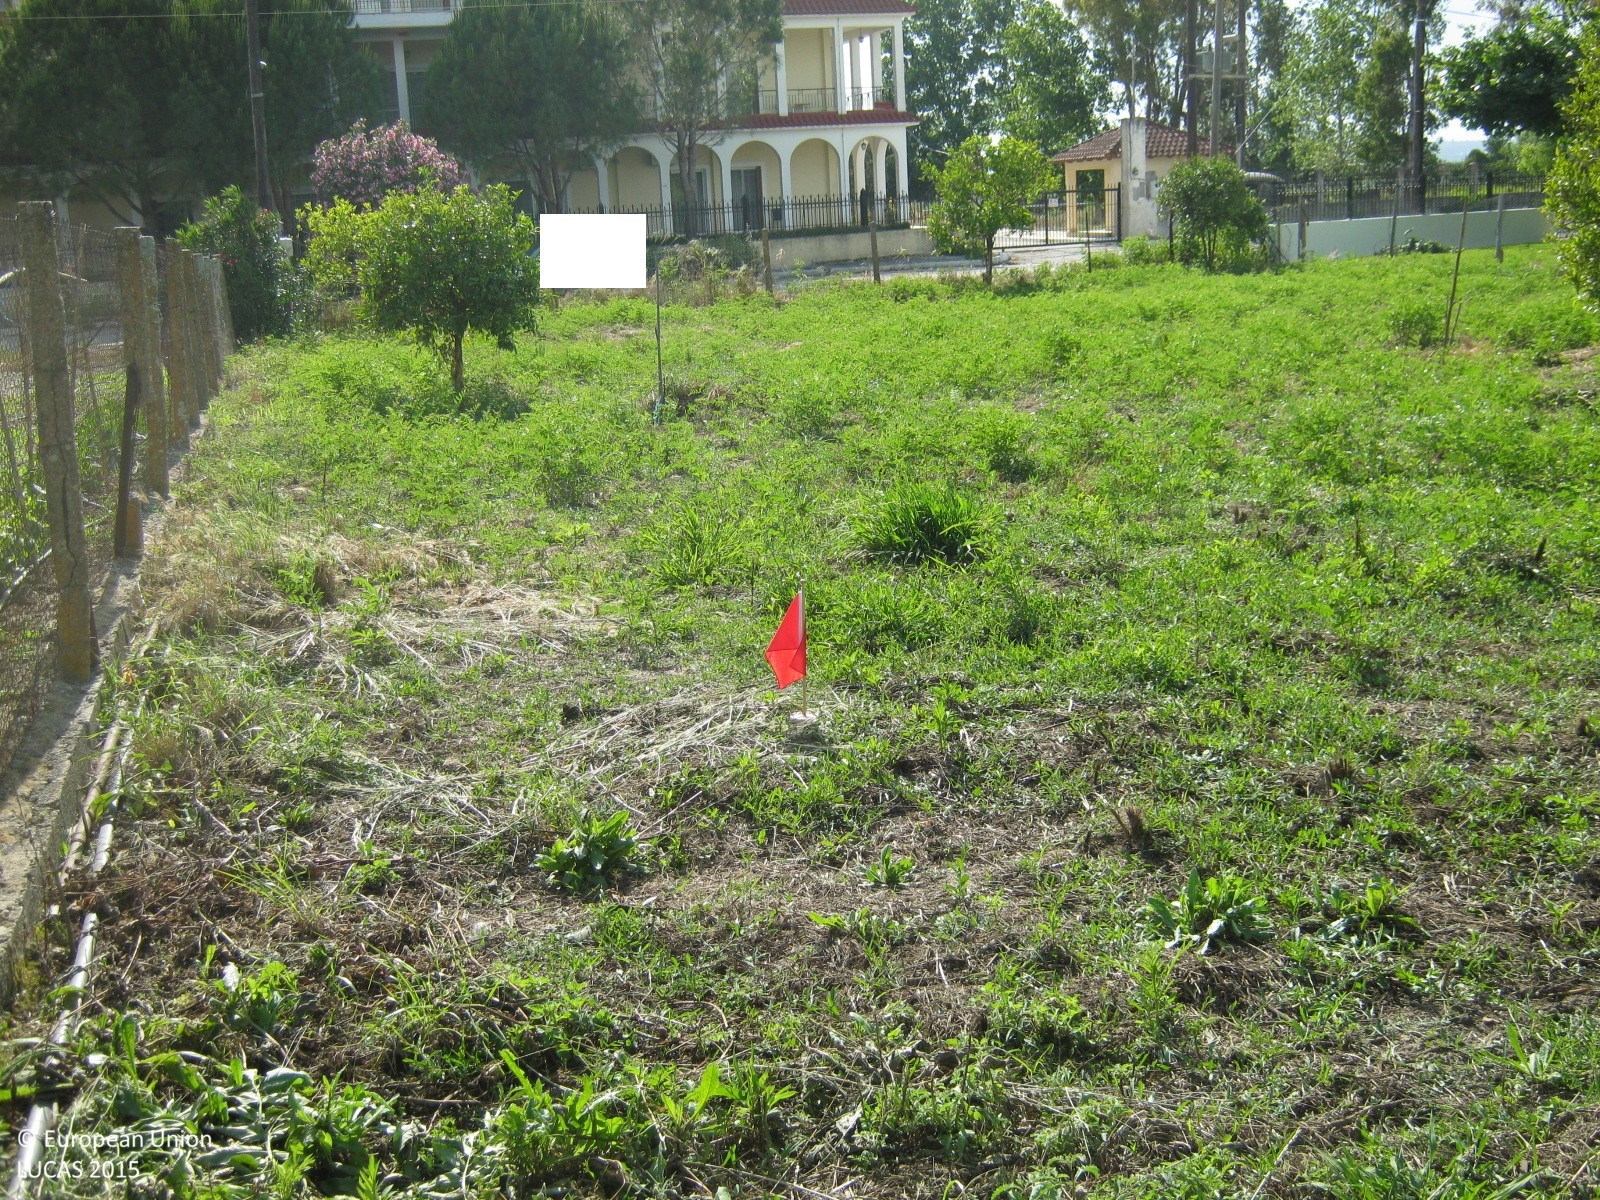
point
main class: Cropland
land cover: Oranges
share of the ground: 10 - 25 %
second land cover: Spontaneously vegetated surfaces
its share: > 75 %
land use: Kitchen garden
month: May
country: GR
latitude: 37.8466
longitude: 21.2446
